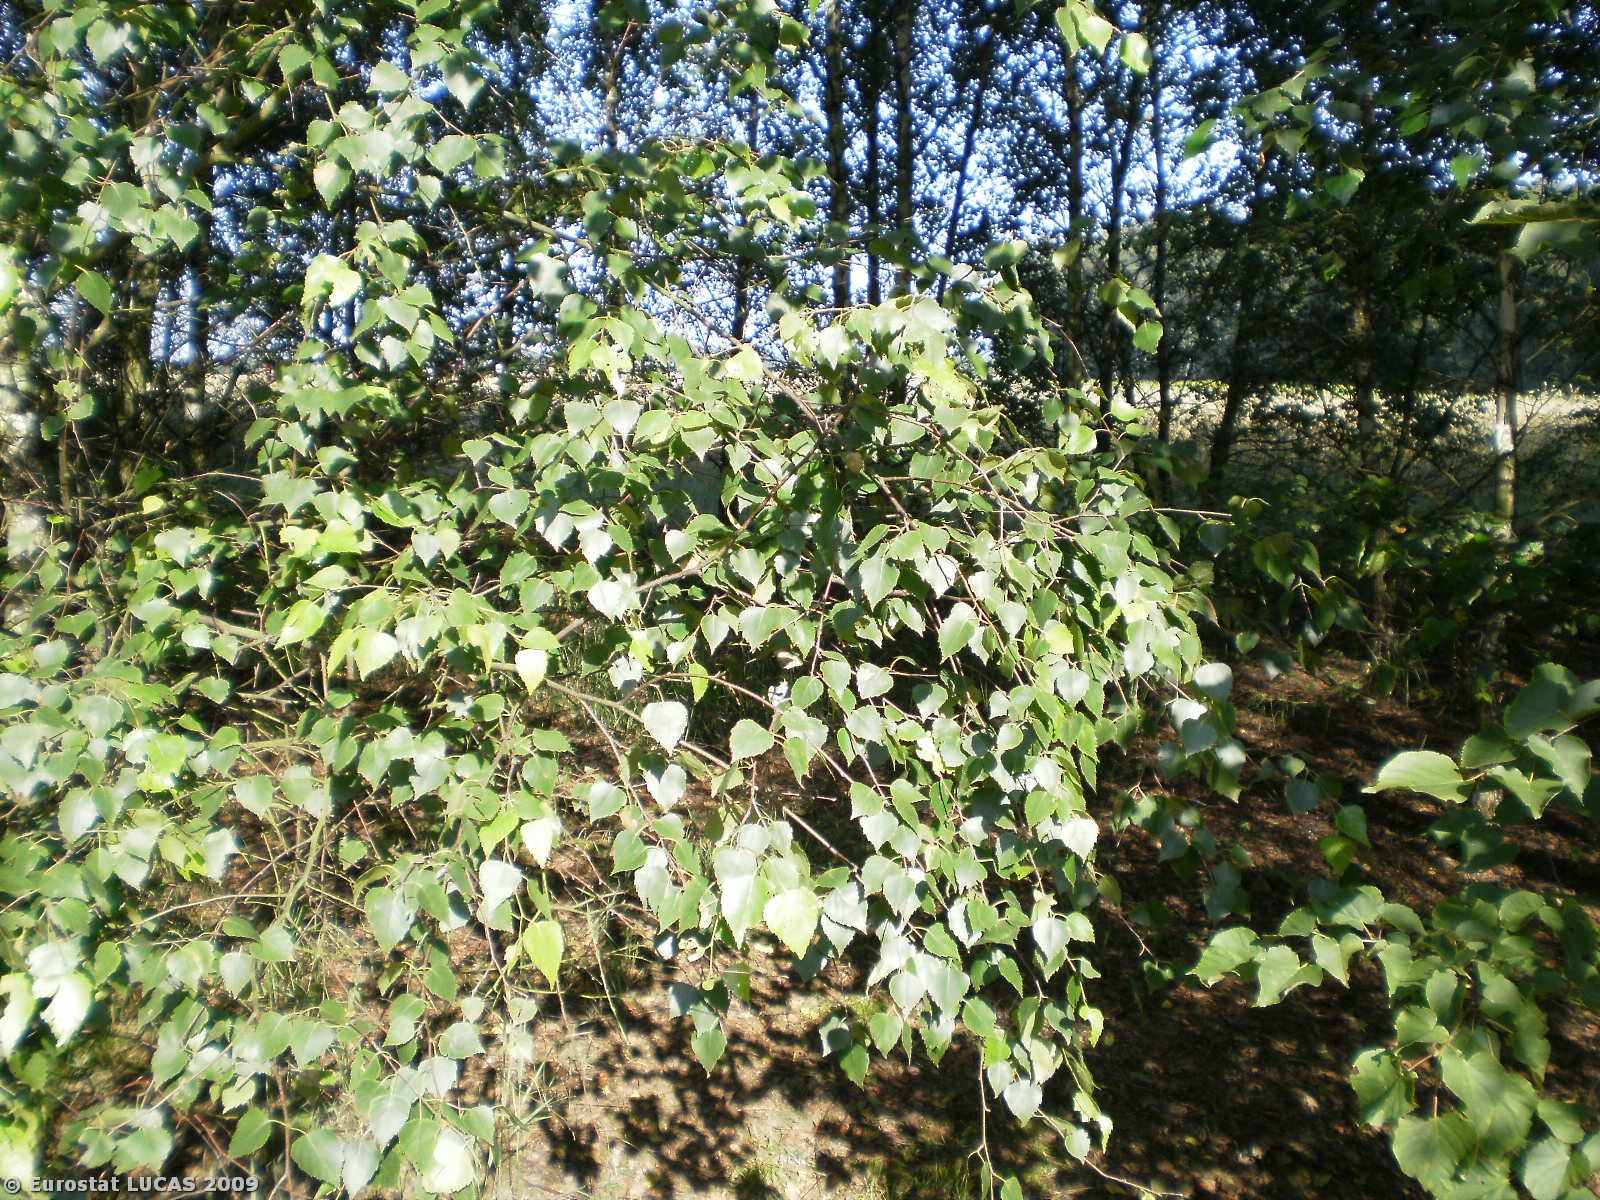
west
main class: Woodland
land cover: Broadleaved woodland
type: mesophytic deciduous forest
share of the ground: > 75 %
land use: Forestry
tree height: > 5 m
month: July
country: PL
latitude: 52.7743
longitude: 20.3683
